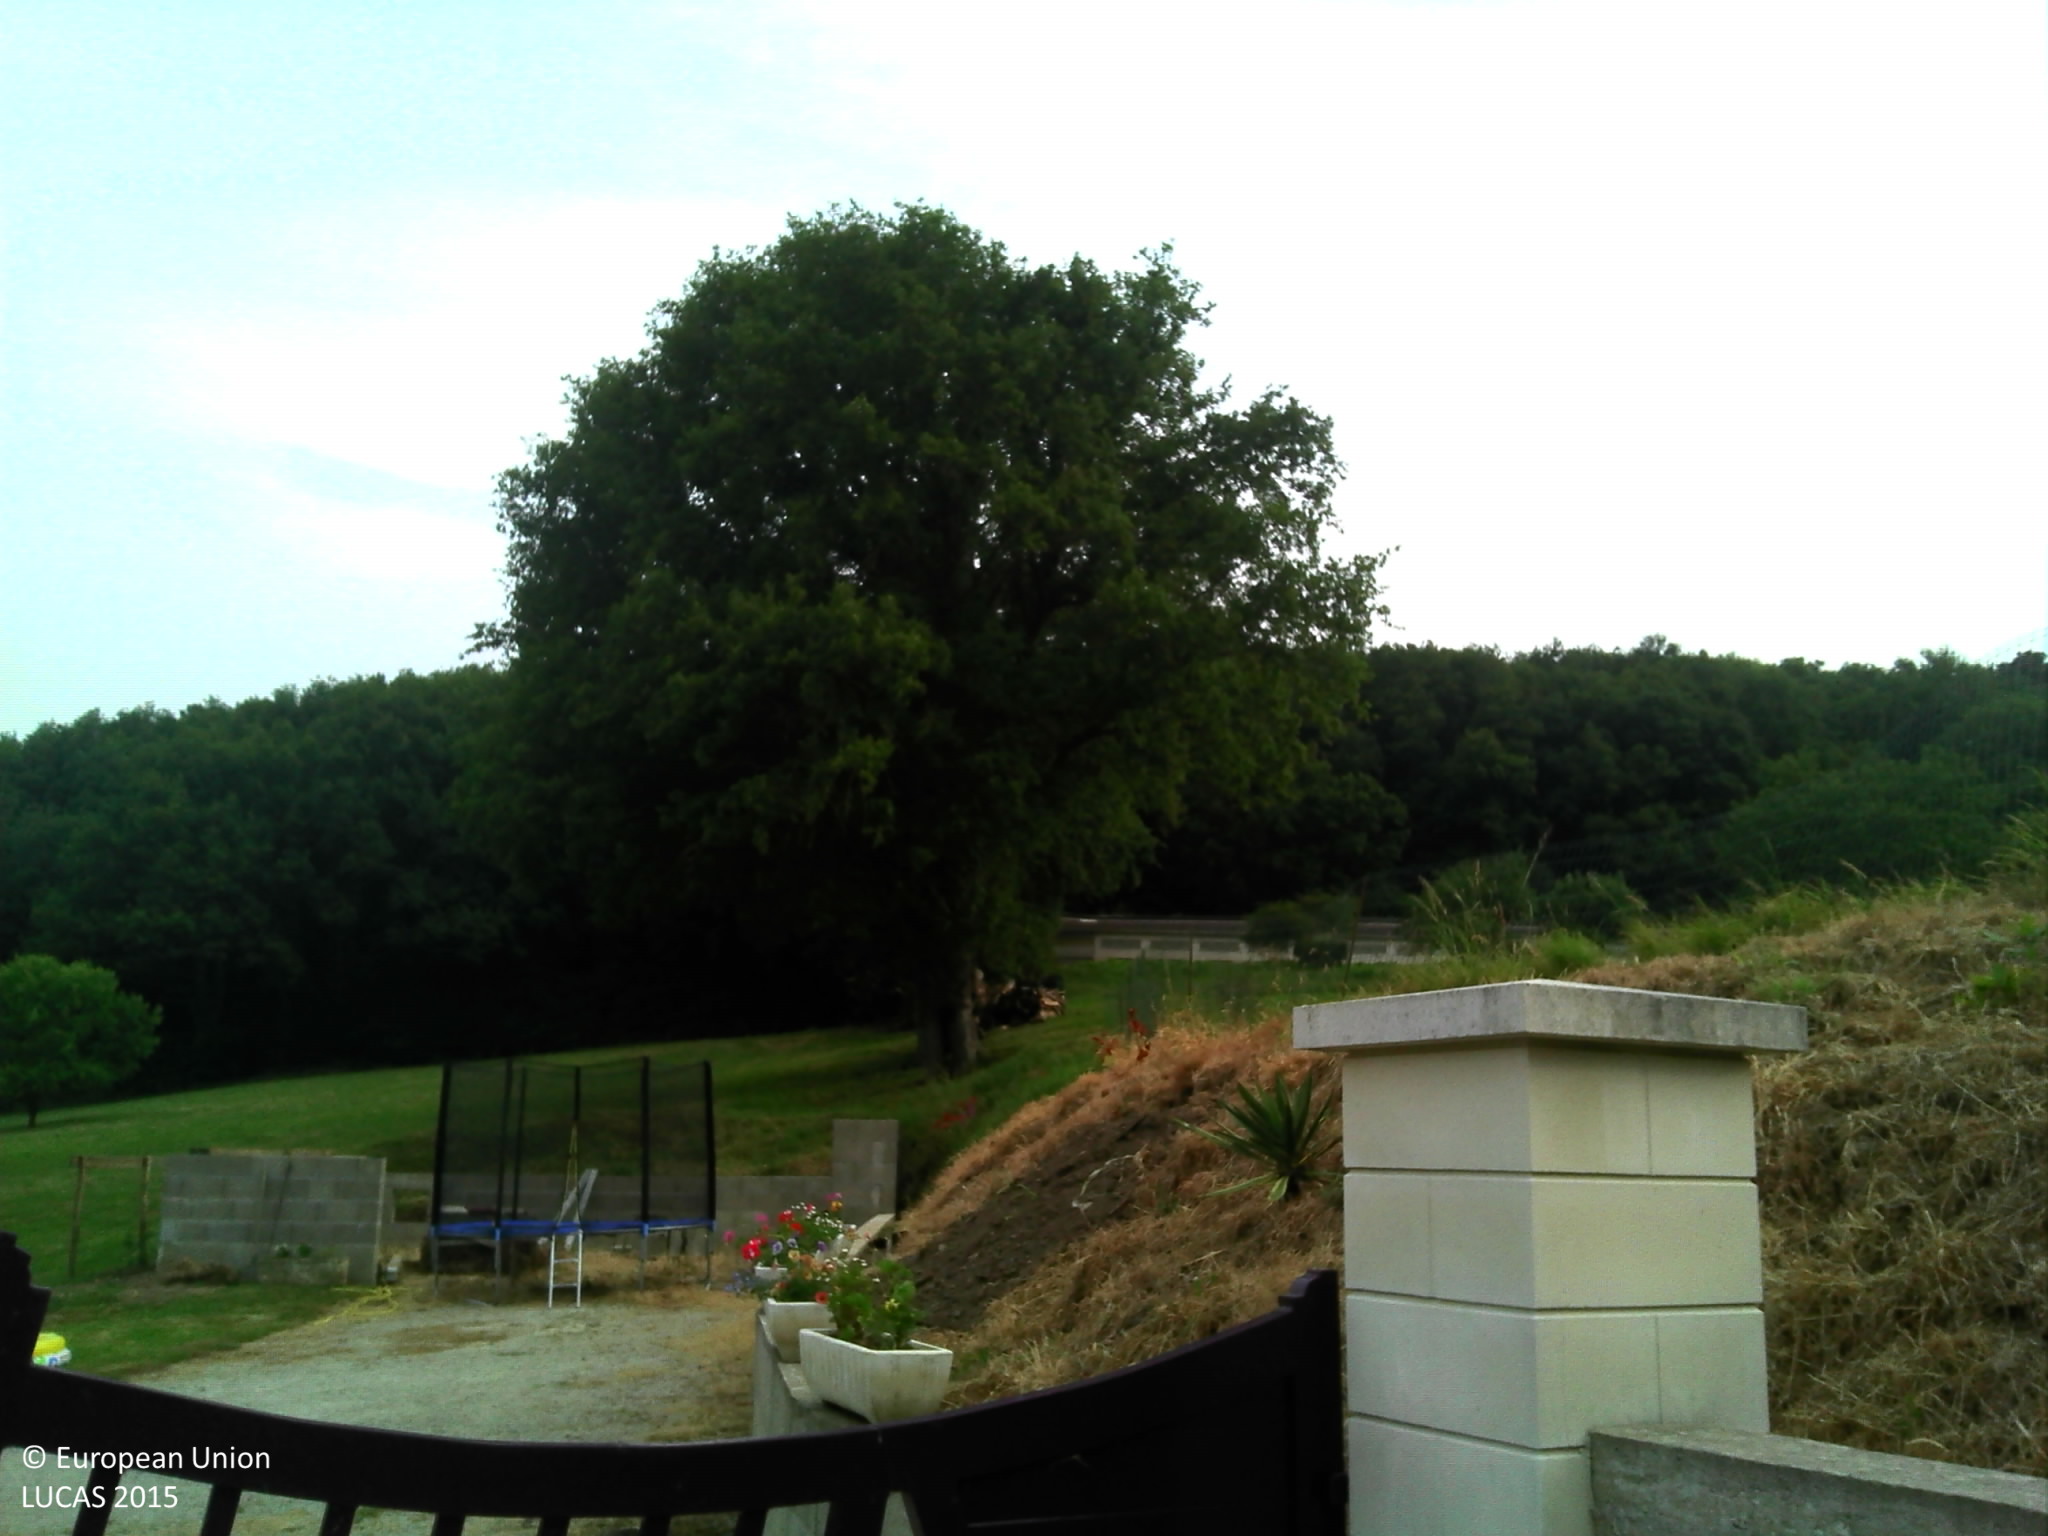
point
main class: Woodland
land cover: Broadleaved woodland
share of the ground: > 75 %
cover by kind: broadleaved forest trees 70 %, herbaceous plants 30 %
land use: Semi-natural and natural areas not in use
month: June
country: FR
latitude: 48.2515
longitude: -0.0631
